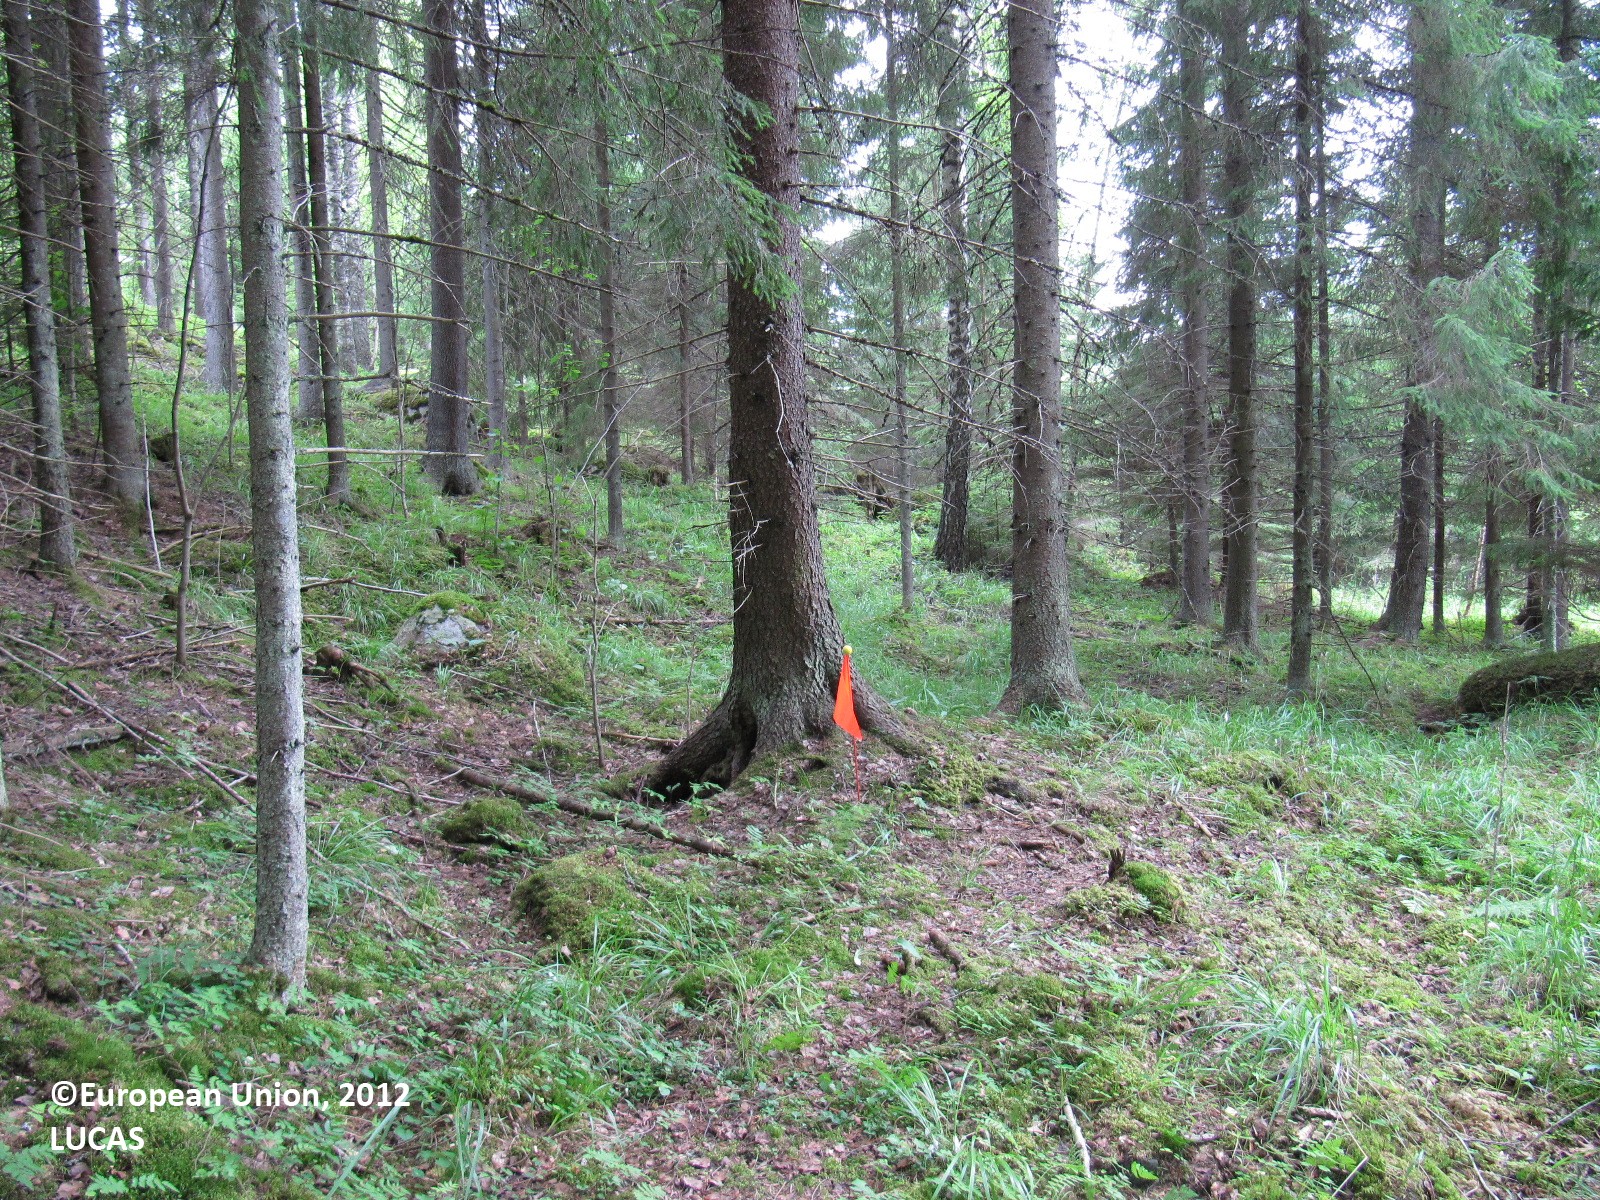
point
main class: Woodland
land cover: Spruce dominated mixed woodland
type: boreal forest
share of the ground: > 75 %
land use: Forestry
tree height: > 5 m
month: July
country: FI
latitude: 60.8309
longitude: 24.5810
